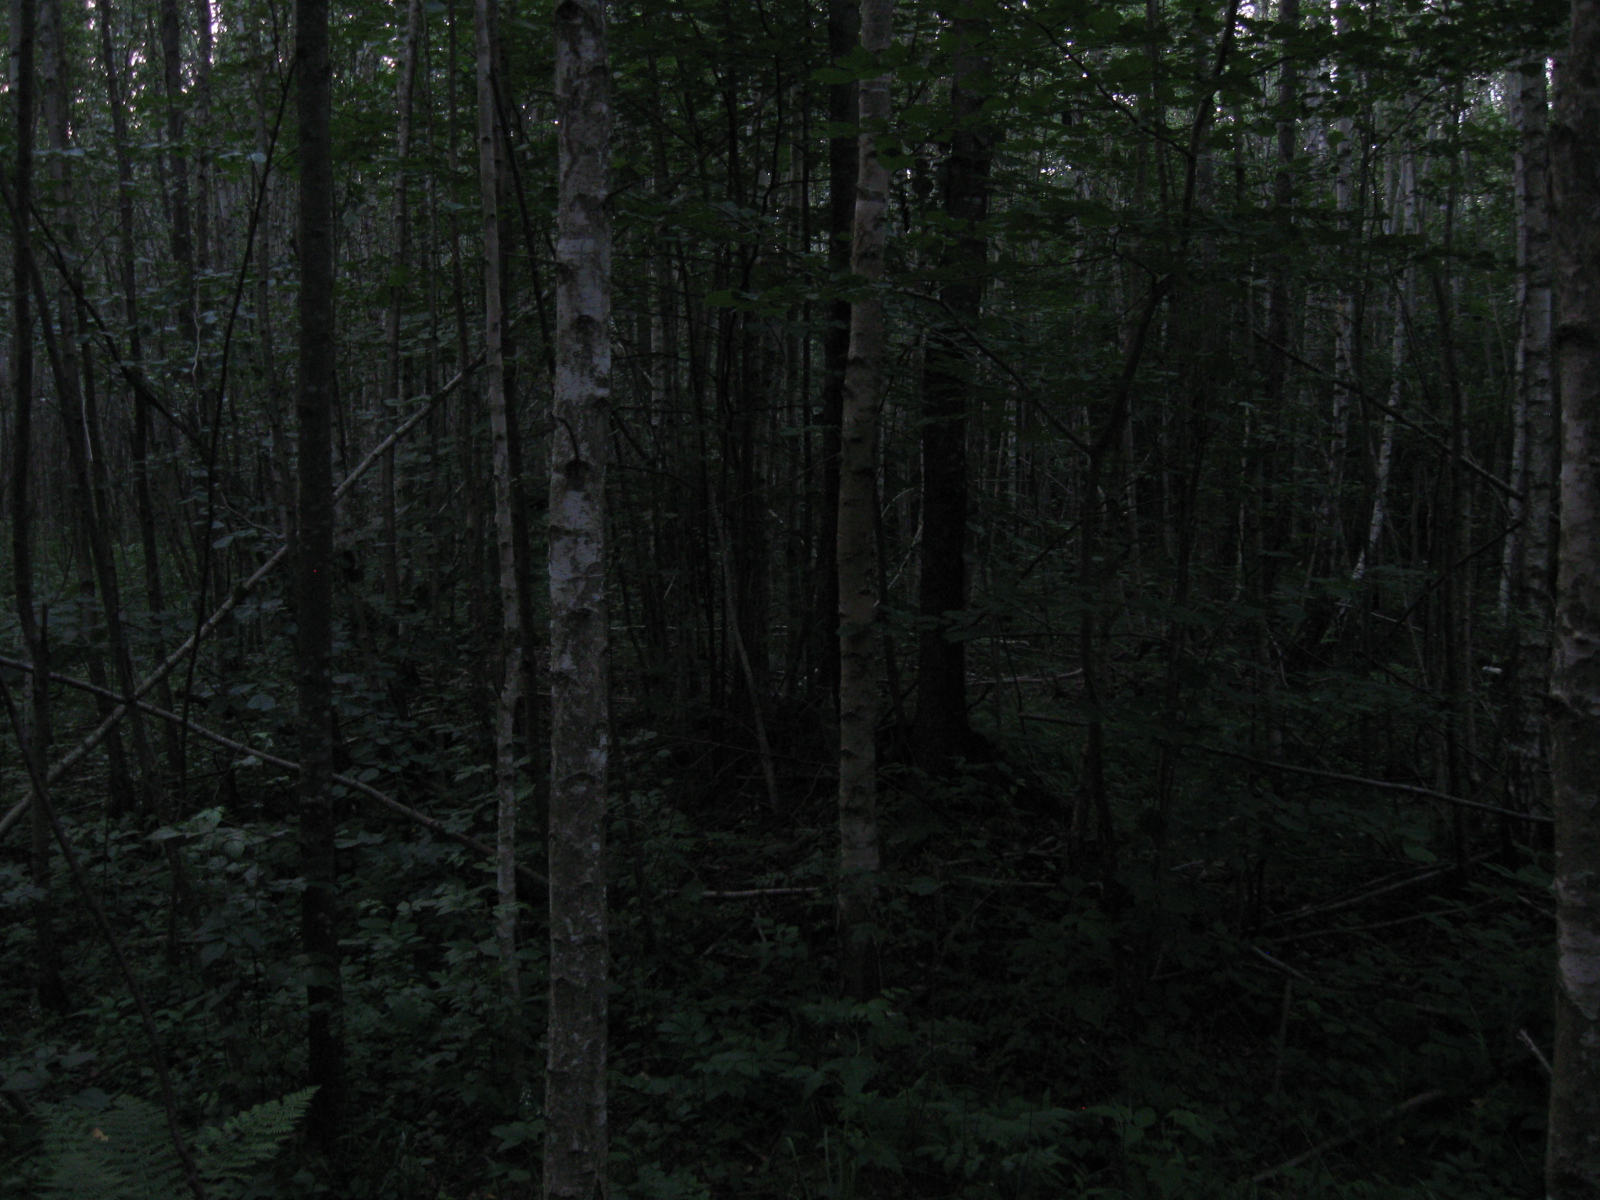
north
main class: Woodland
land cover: Broadleaved woodland
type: non-riverine alder, birch or aspen forest
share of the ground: > 75 %
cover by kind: broadleaved forest trees 85 %, herbaceous plants 10 %, shrubs 5 %
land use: Forestry
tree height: > 5 m
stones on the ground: < 10 %
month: July
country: LT
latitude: 55.0866
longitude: 23.6668
